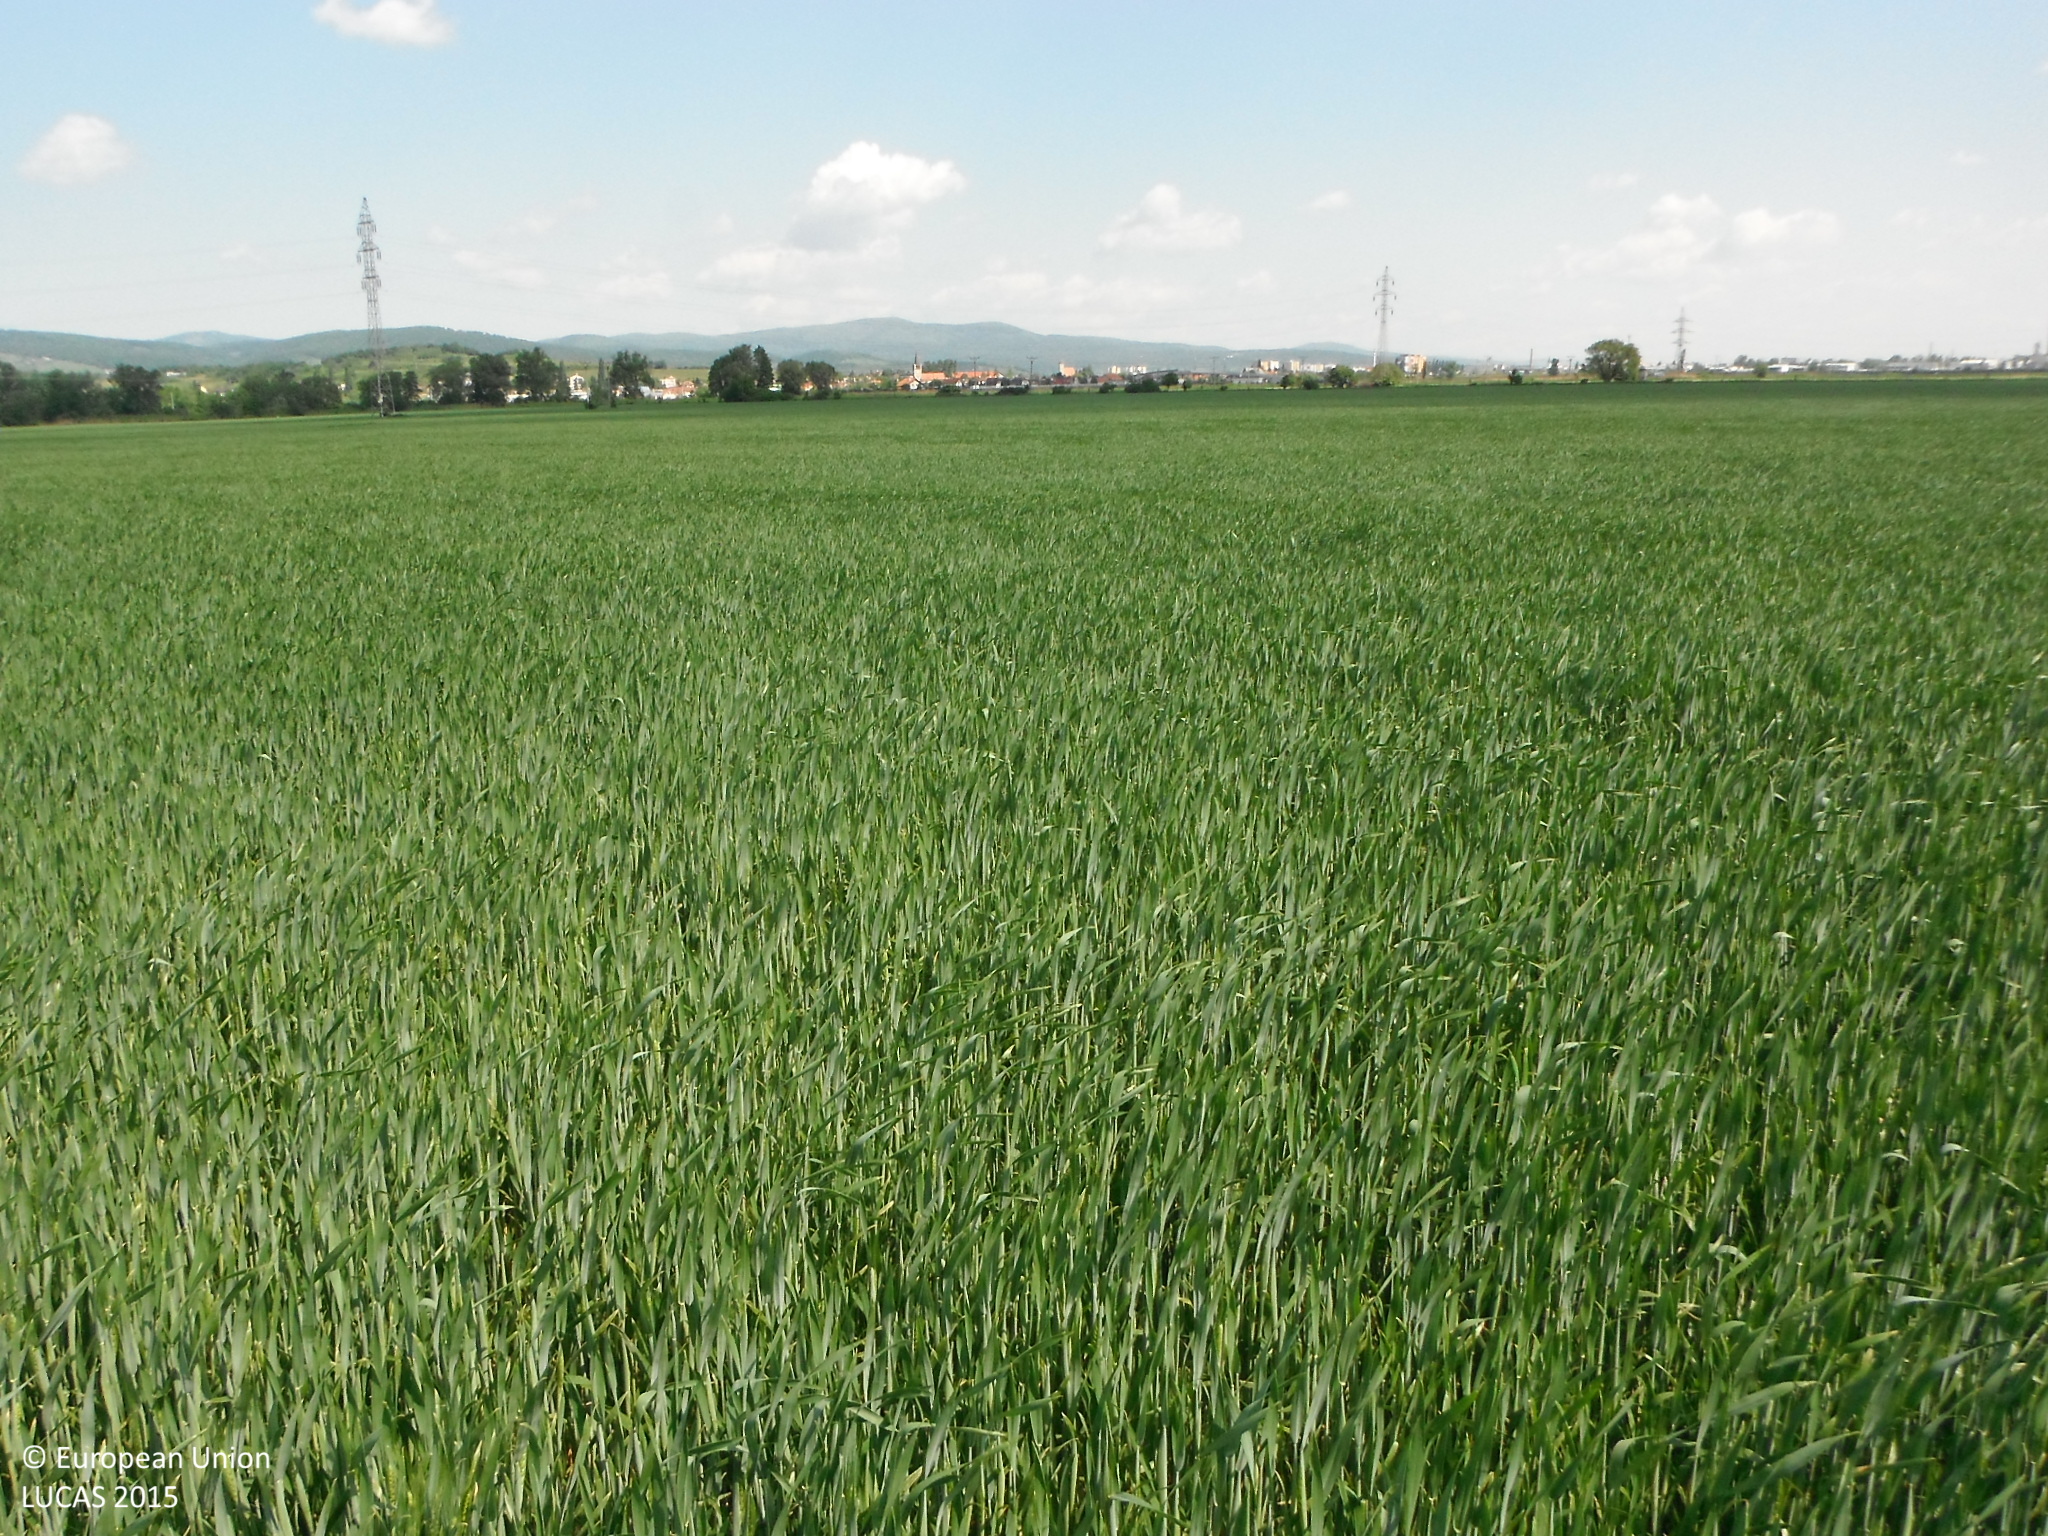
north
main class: Cropland
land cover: Common wheat
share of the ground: > 75 %
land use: Agriculture (excluding fallow land and kitchen gardens)
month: May
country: SK
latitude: 48.2562
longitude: 17.2418
